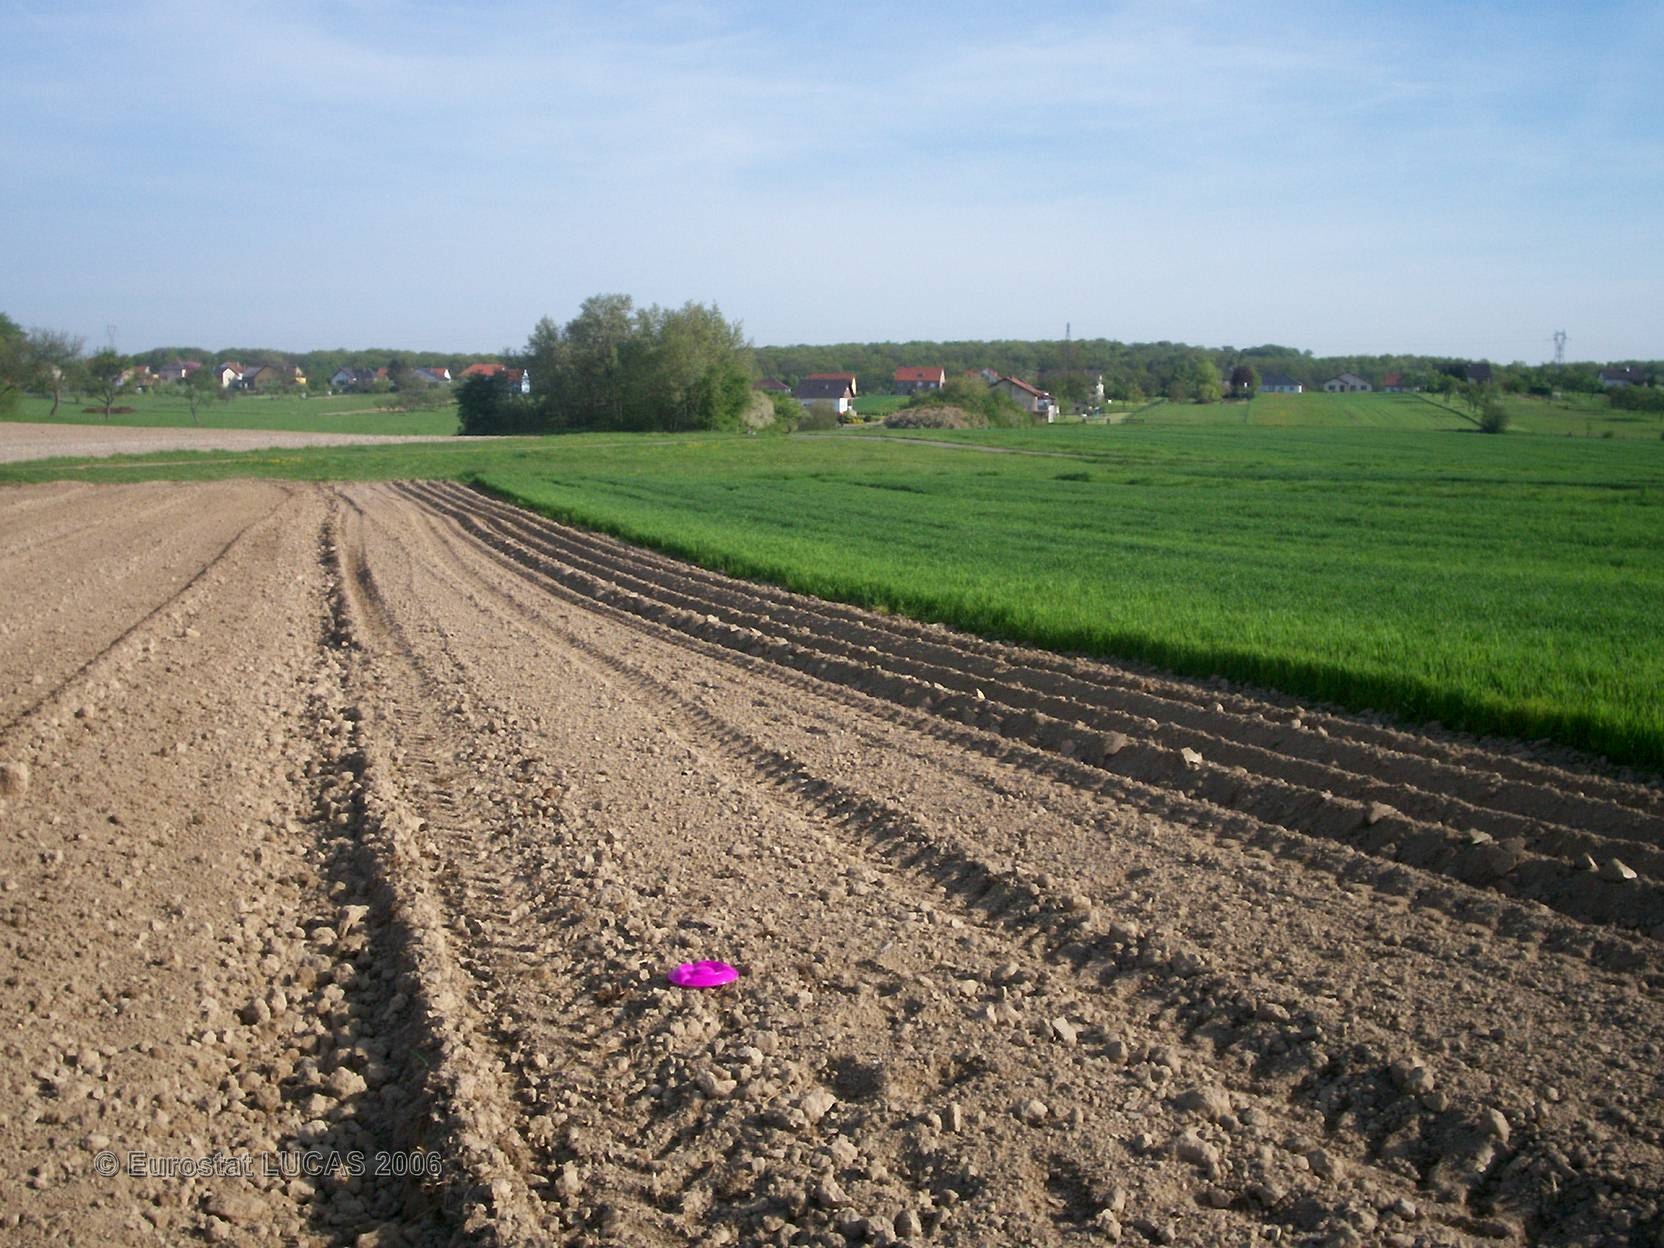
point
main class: Cropland
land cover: Maize
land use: Agriculture (excluding fallow land and kitchen gardens)
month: May
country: FR
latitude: 49.0089
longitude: 6.9243
